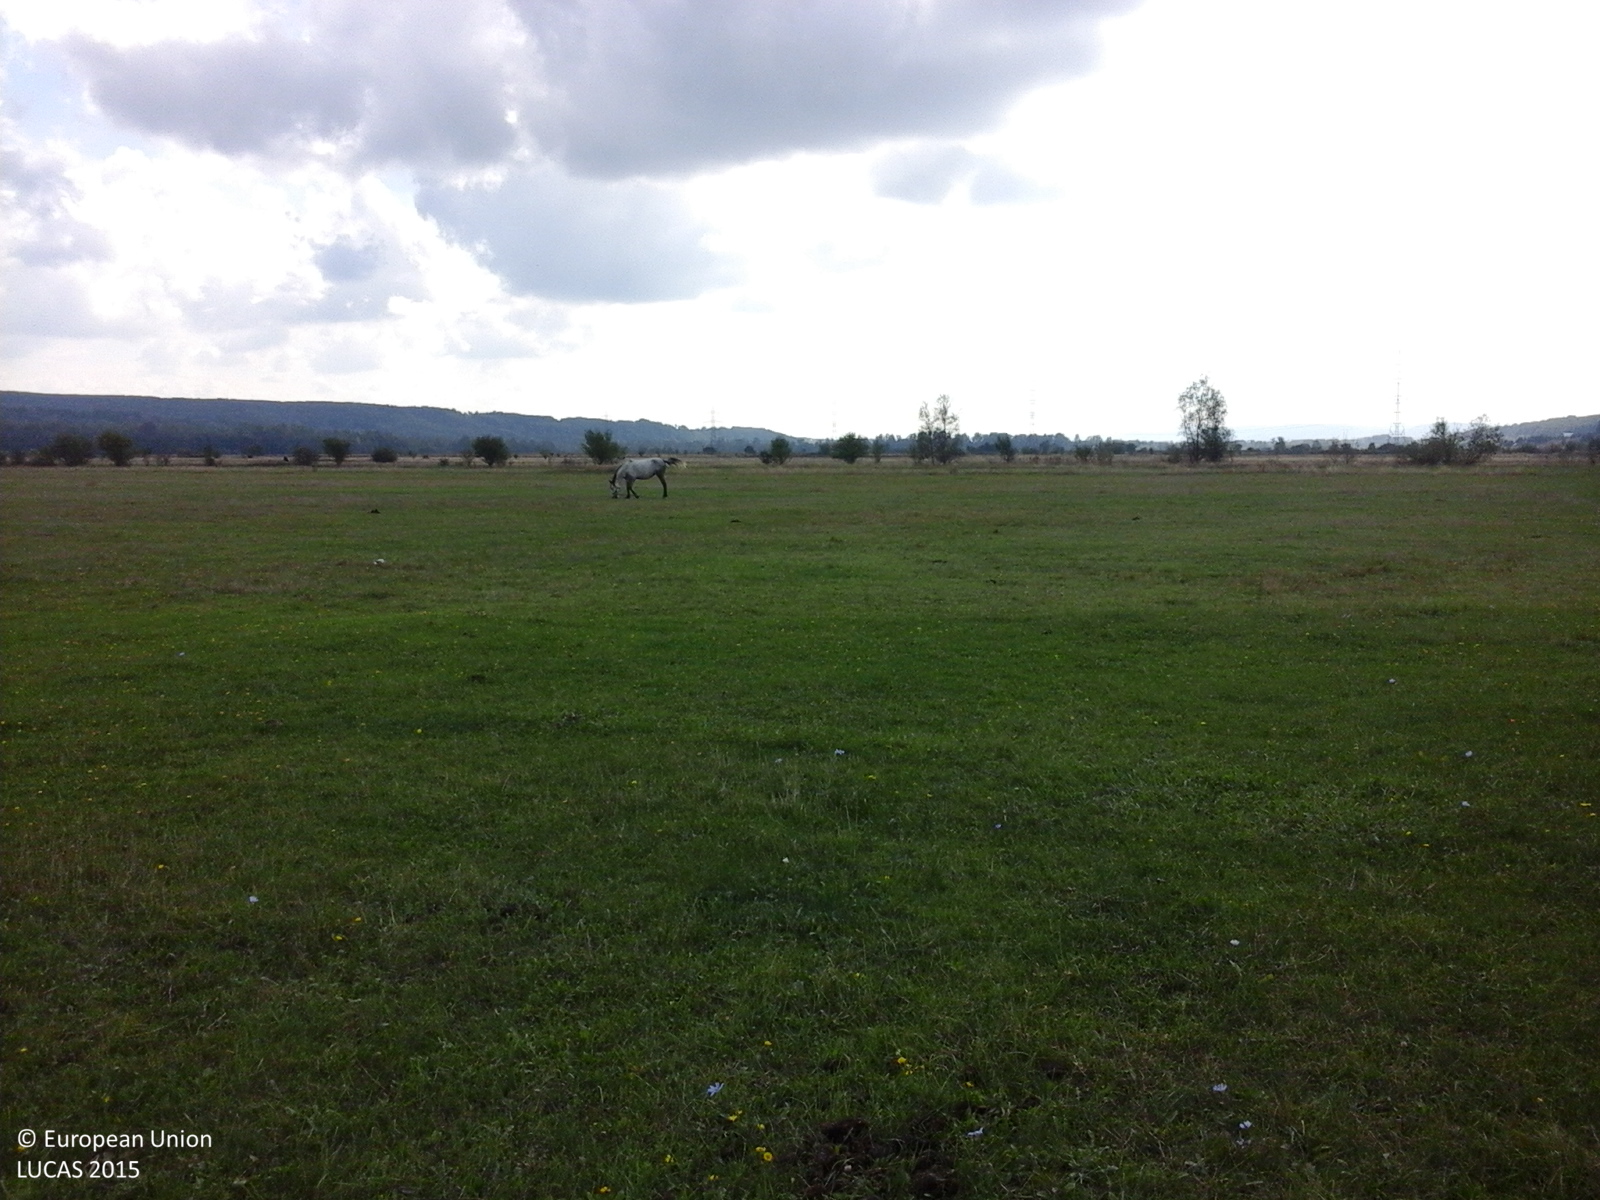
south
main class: Grassland
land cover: Grassland without tree/shrub cover
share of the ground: > 75 %
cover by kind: herbaceous plants 100 %
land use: Agriculture (excluding fallow land and kitchen gardens)
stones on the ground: < 10 %
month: September
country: RO
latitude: 44.9924
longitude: 23.5412
